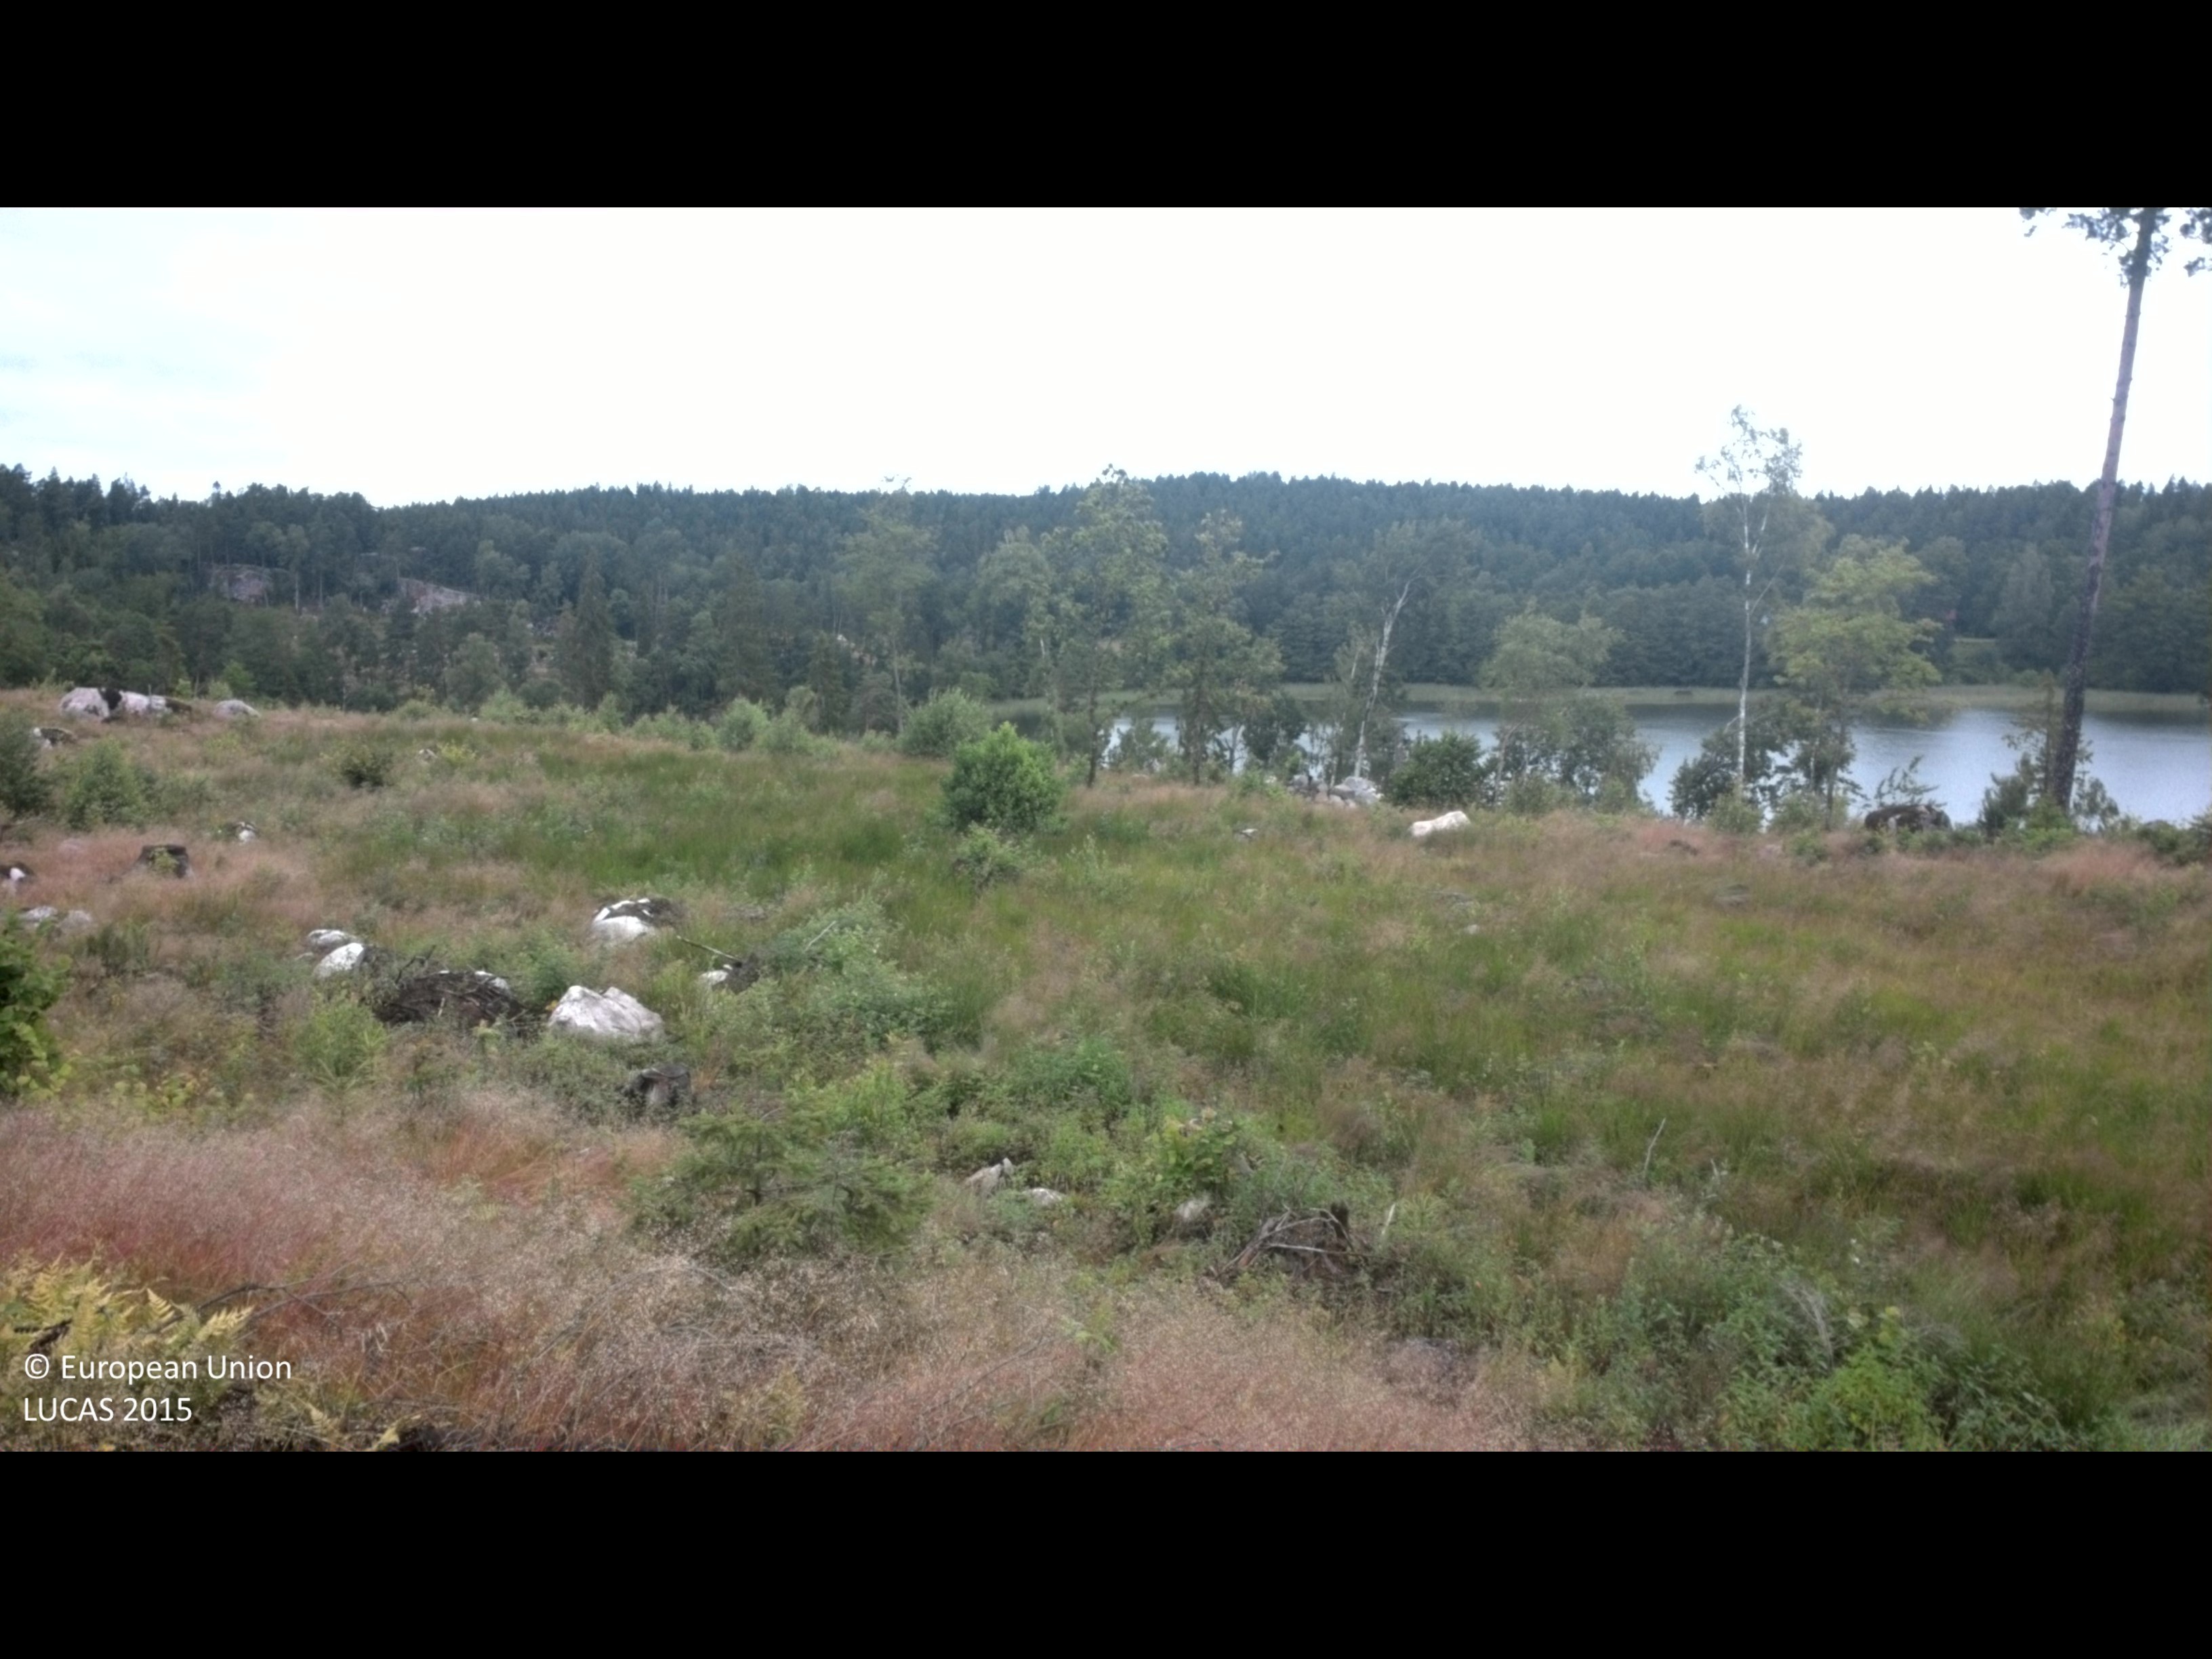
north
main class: Woodland
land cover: Other mixed woodland
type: boreal forest
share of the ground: 10 - 25 %
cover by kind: shrubs 45 %, herbaceous plants 40 %, broadleaved forest trees 10 %, coniferous forest trees 5 %
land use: Forestry
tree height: < 5 m
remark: Clear cut
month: July
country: SE
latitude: 58.3146
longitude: 16.1237
